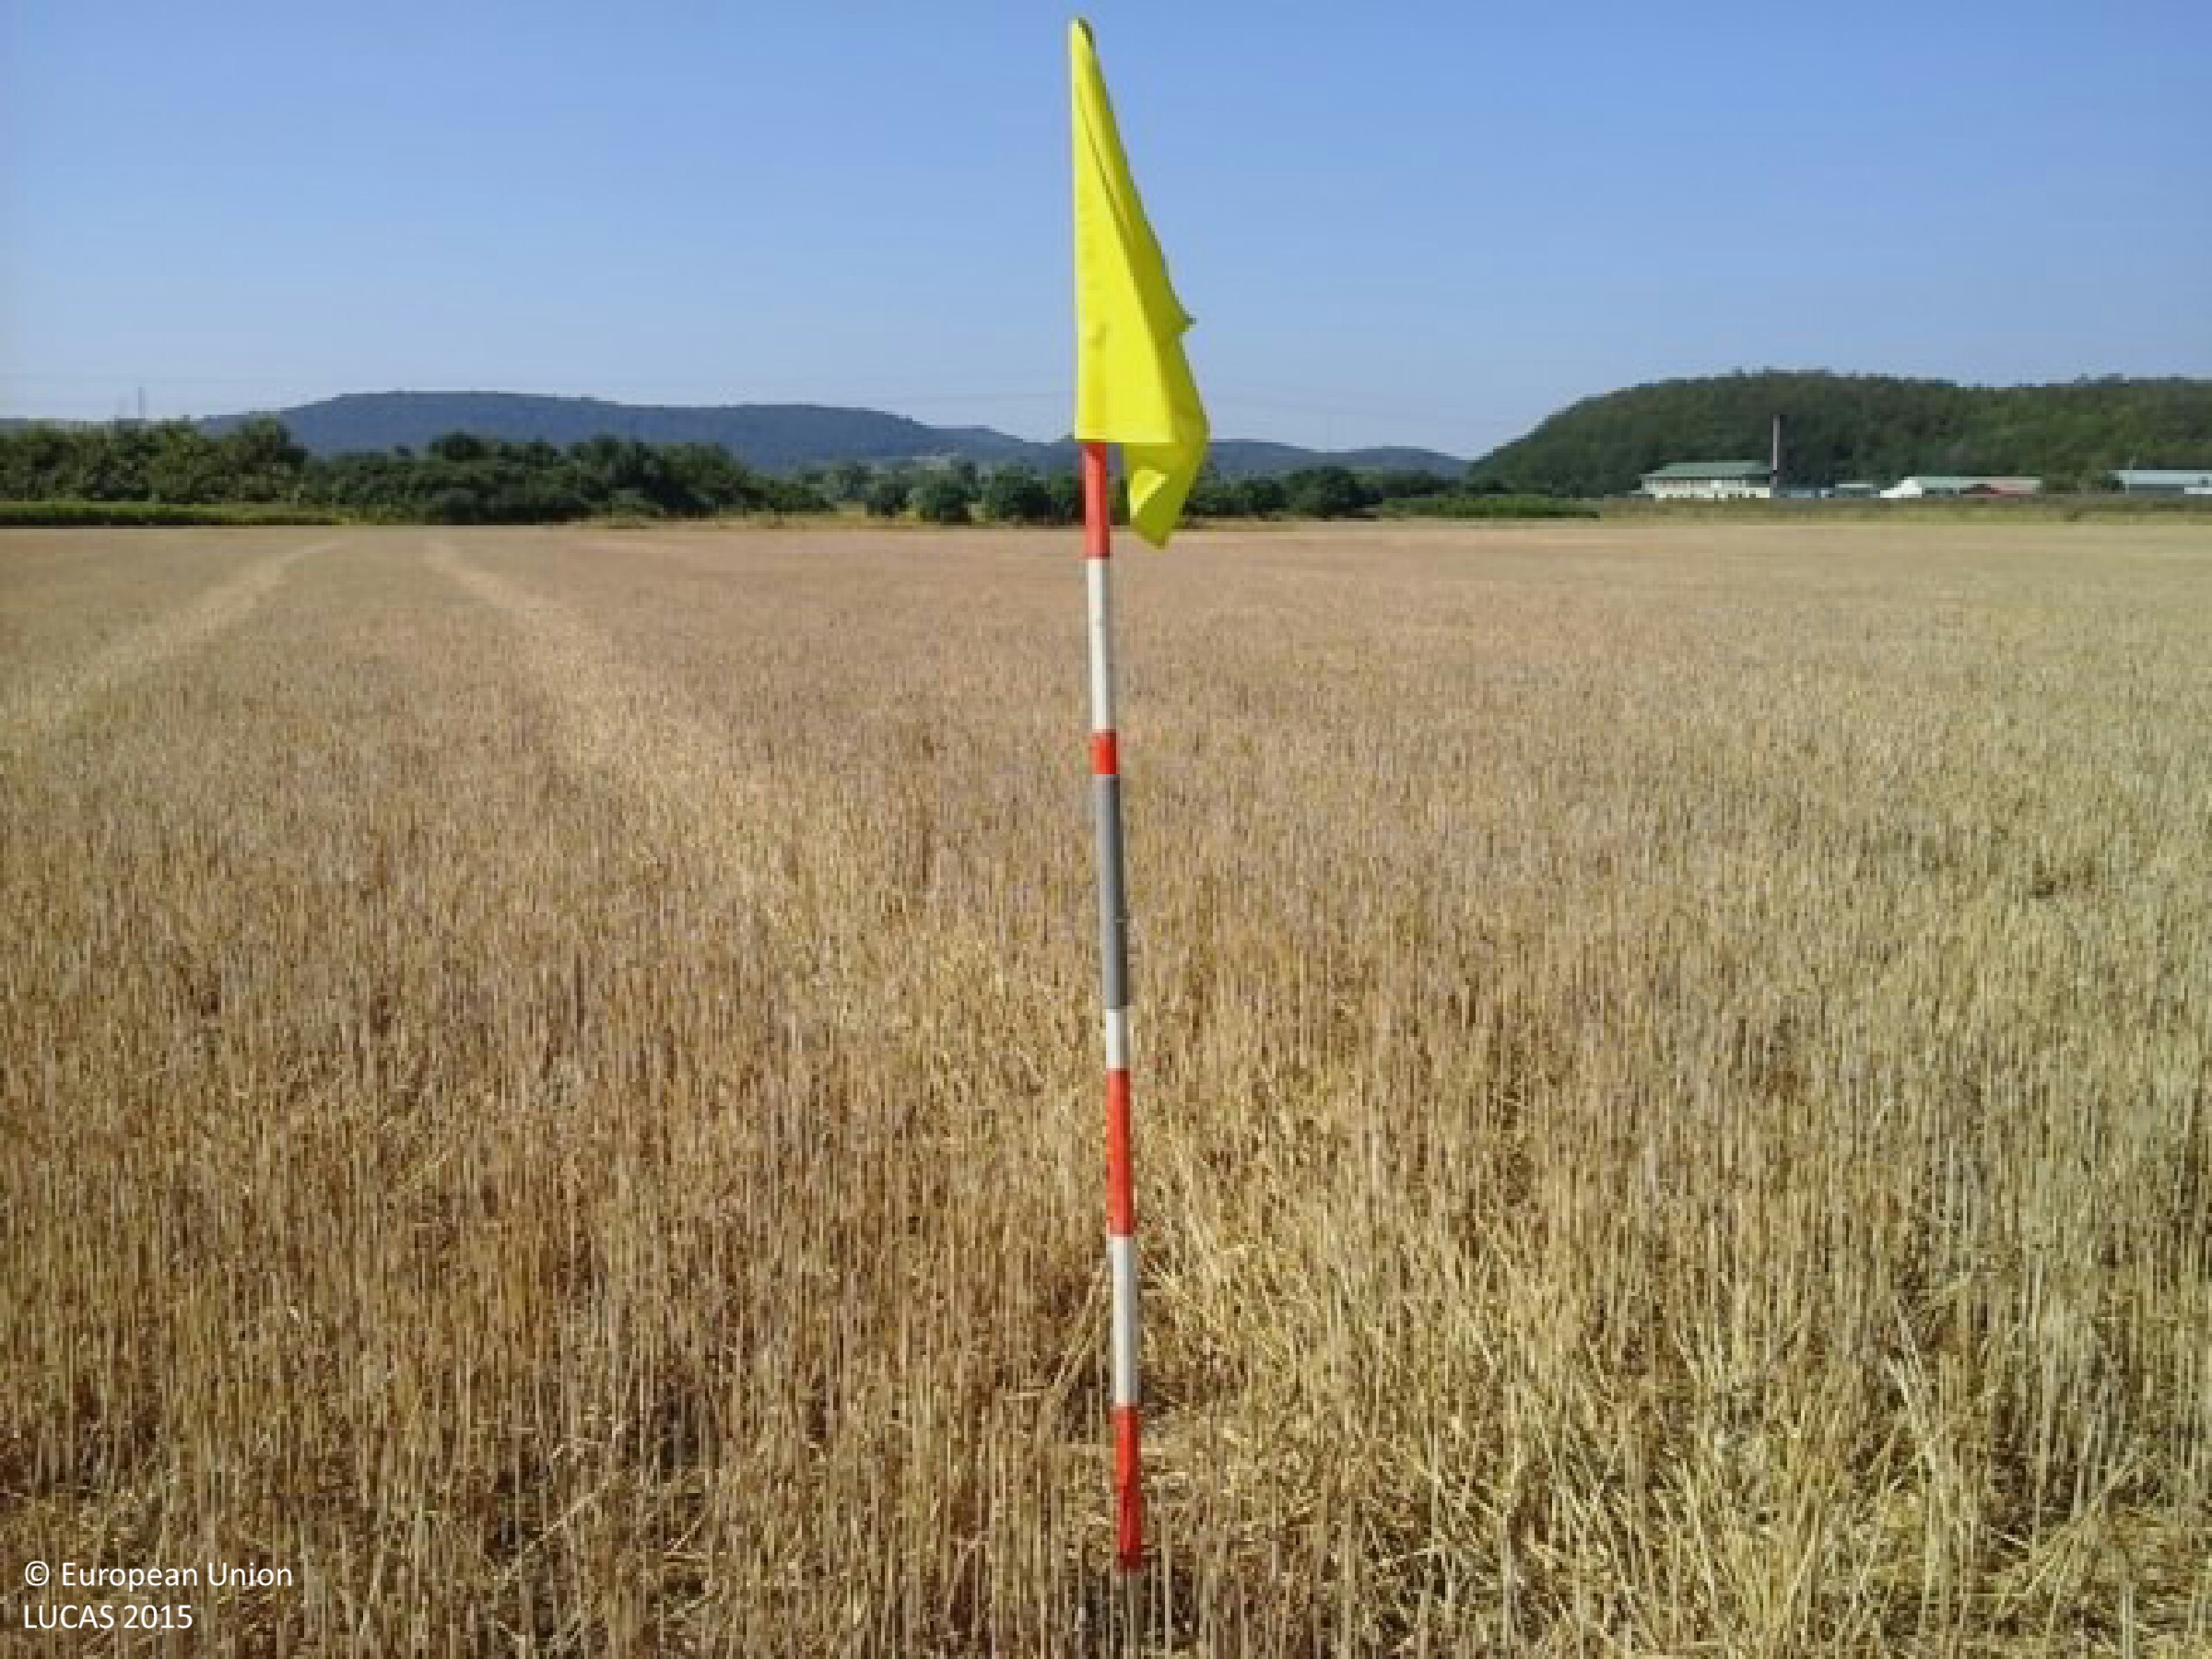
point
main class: Cropland
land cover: Common wheat
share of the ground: > 75 %
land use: Agriculture (excluding fallow land and kitchen gardens)
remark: Harvested field
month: July
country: HU
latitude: 48.2672
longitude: 20.6655
